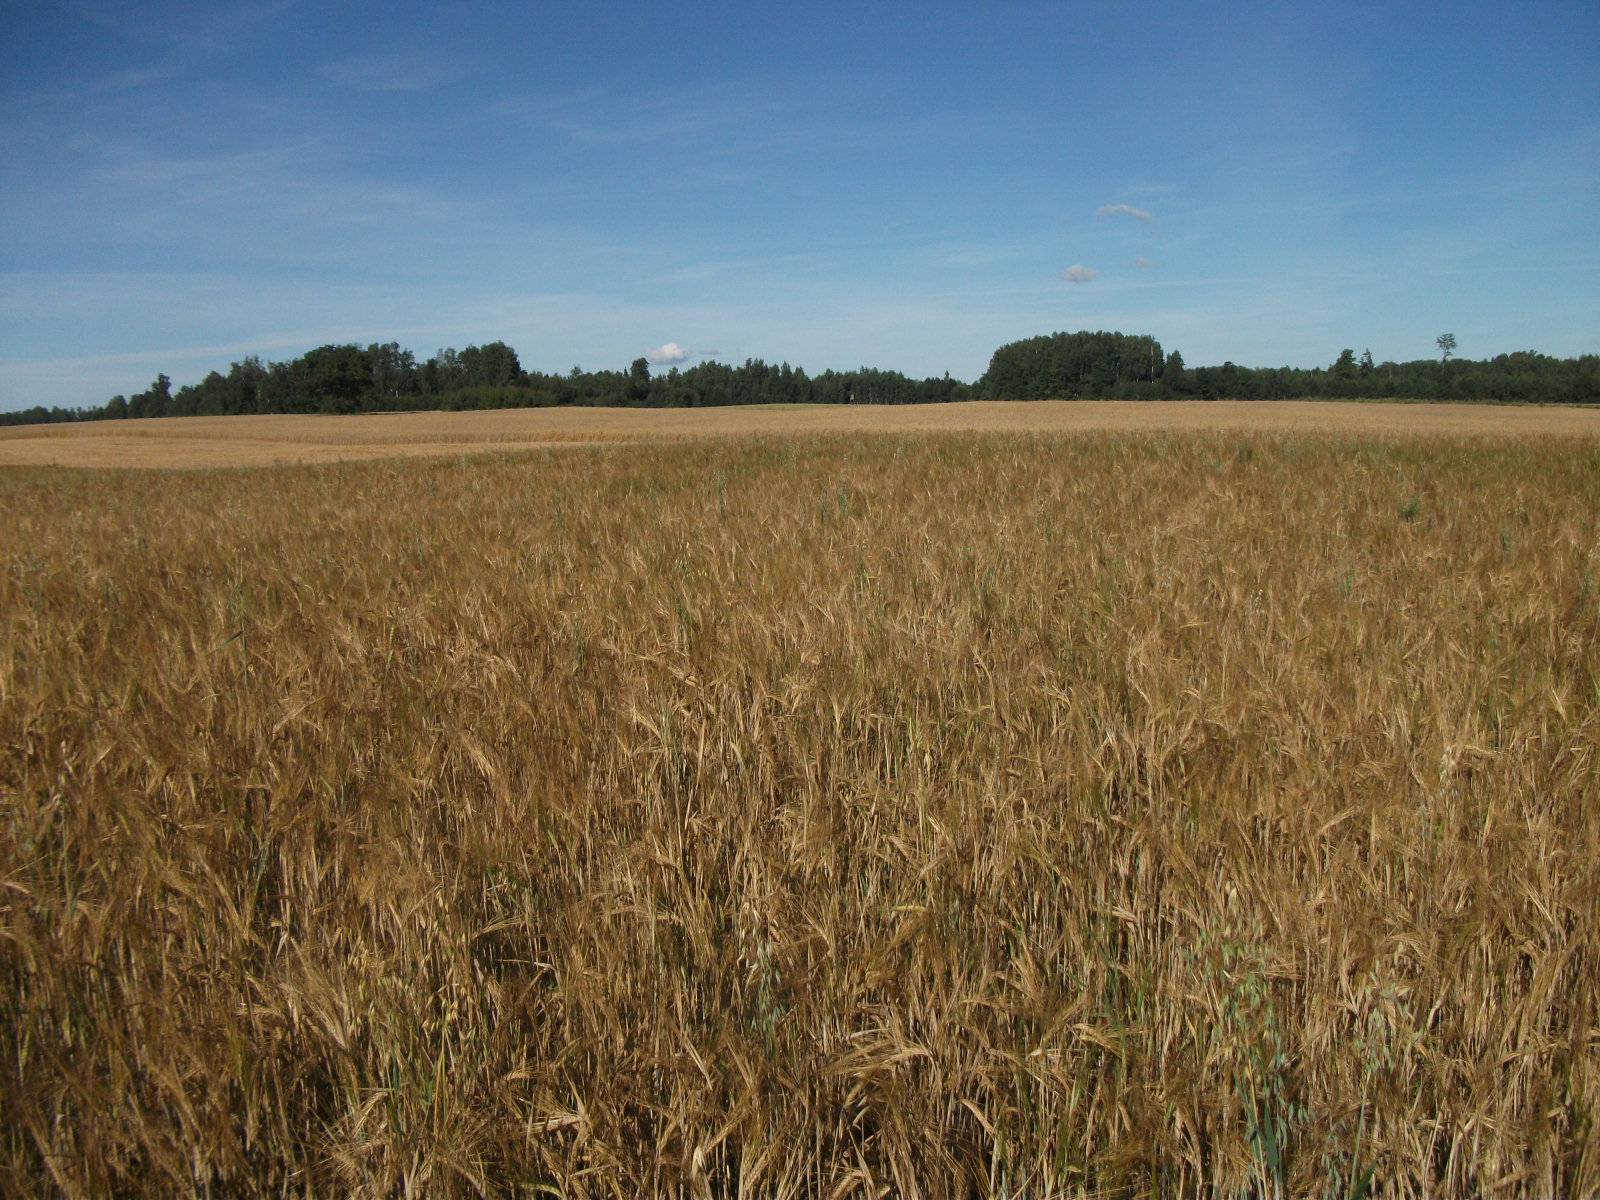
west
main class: Cropland
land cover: Barley
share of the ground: > 75 %
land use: Agriculture (excluding fallow land and kitchen gardens)
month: August
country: LV
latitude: 56.7128
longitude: 26.3319
